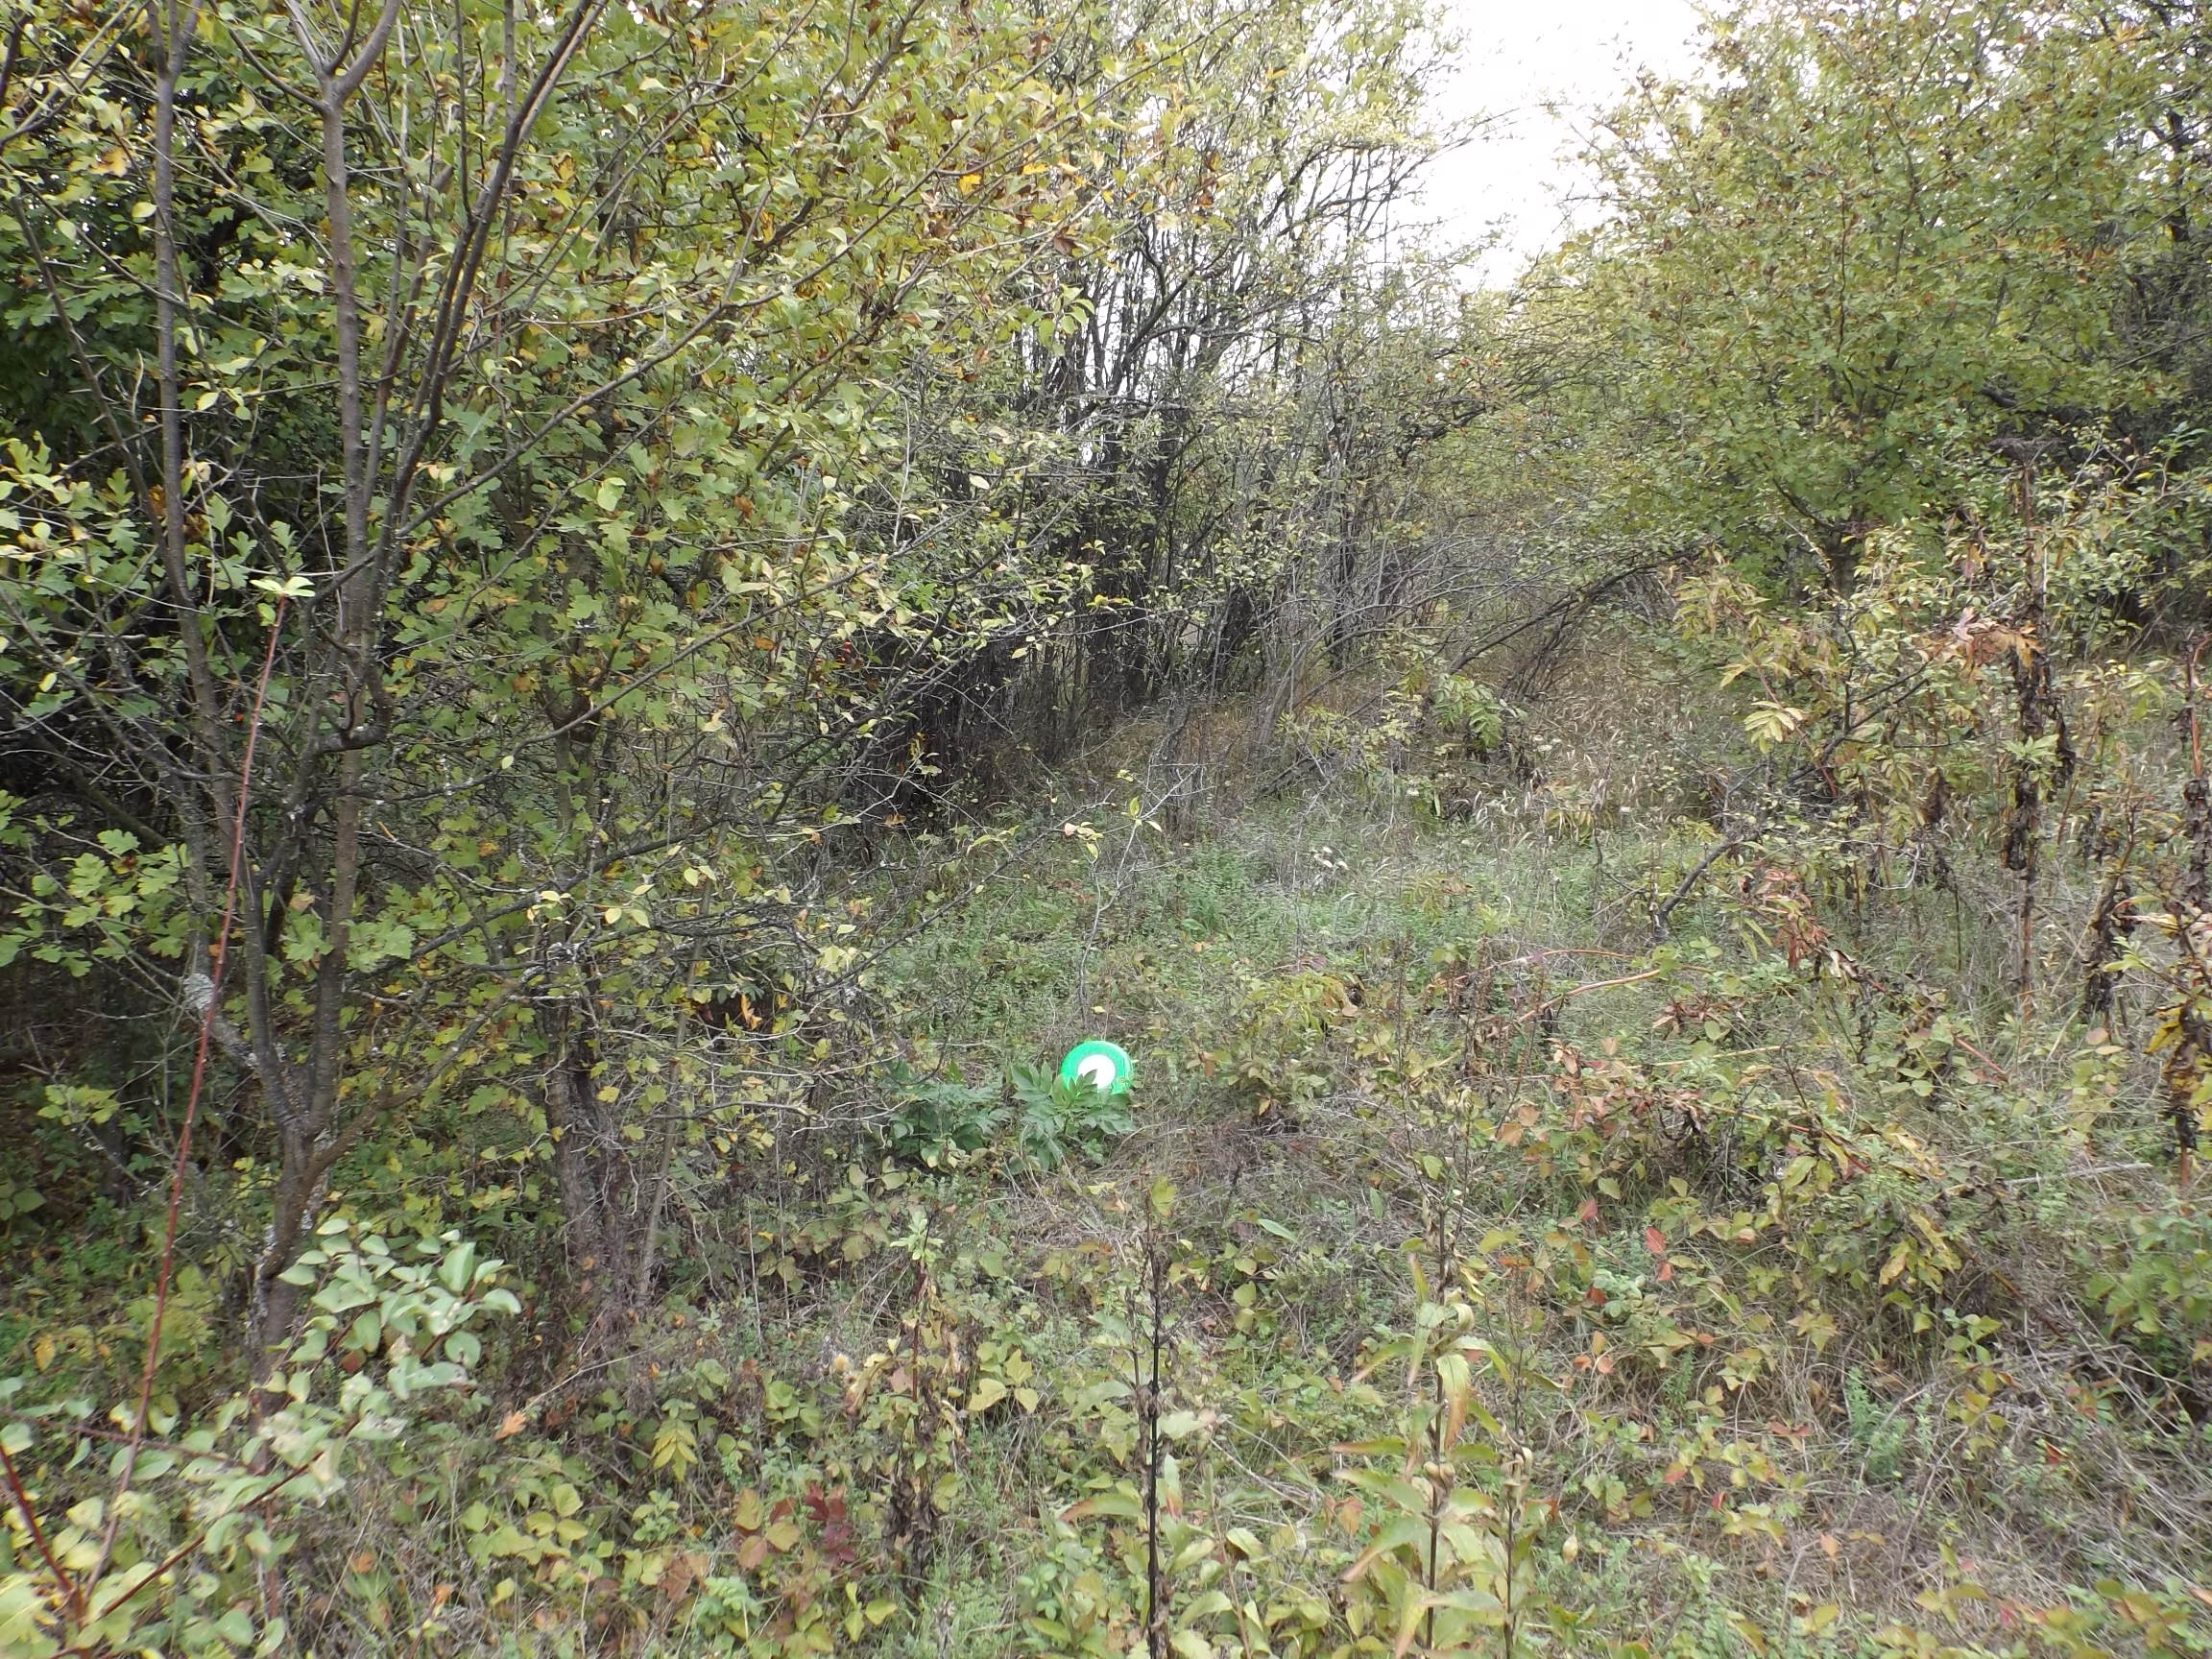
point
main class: Shrubland
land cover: Shrubland with sparse tree cover
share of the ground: > 75 %
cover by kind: shrubs 65 %, herbaceous plants 30 %, broadleaved forest trees 5 %
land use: Semi-natural and natural areas not in use
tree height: > 5 m
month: October
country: BG
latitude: 44.0313
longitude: 26.8263
